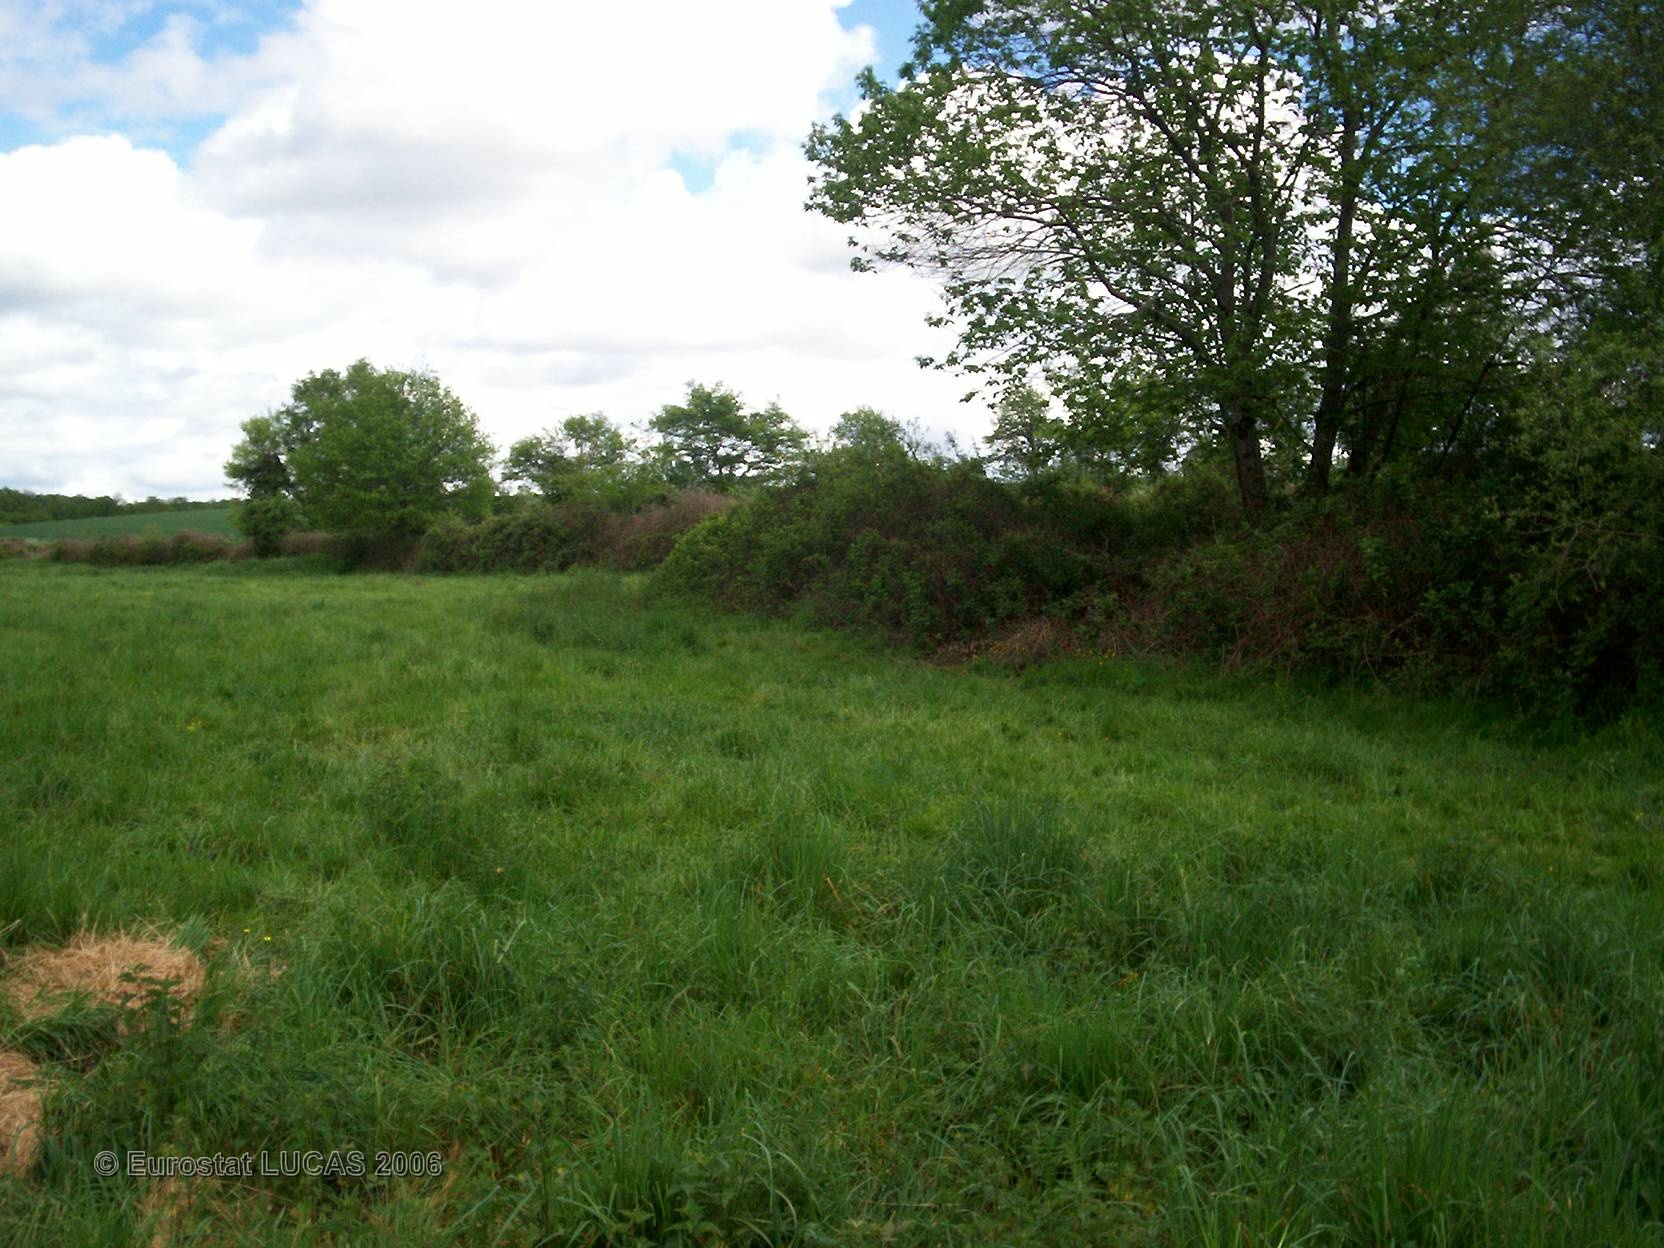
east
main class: Grassland
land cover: Grassland without tree/shrub cover
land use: Agriculture (excluding fallow land and kitchen gardens)
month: May
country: FR
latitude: 45.9771
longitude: 0.4461
